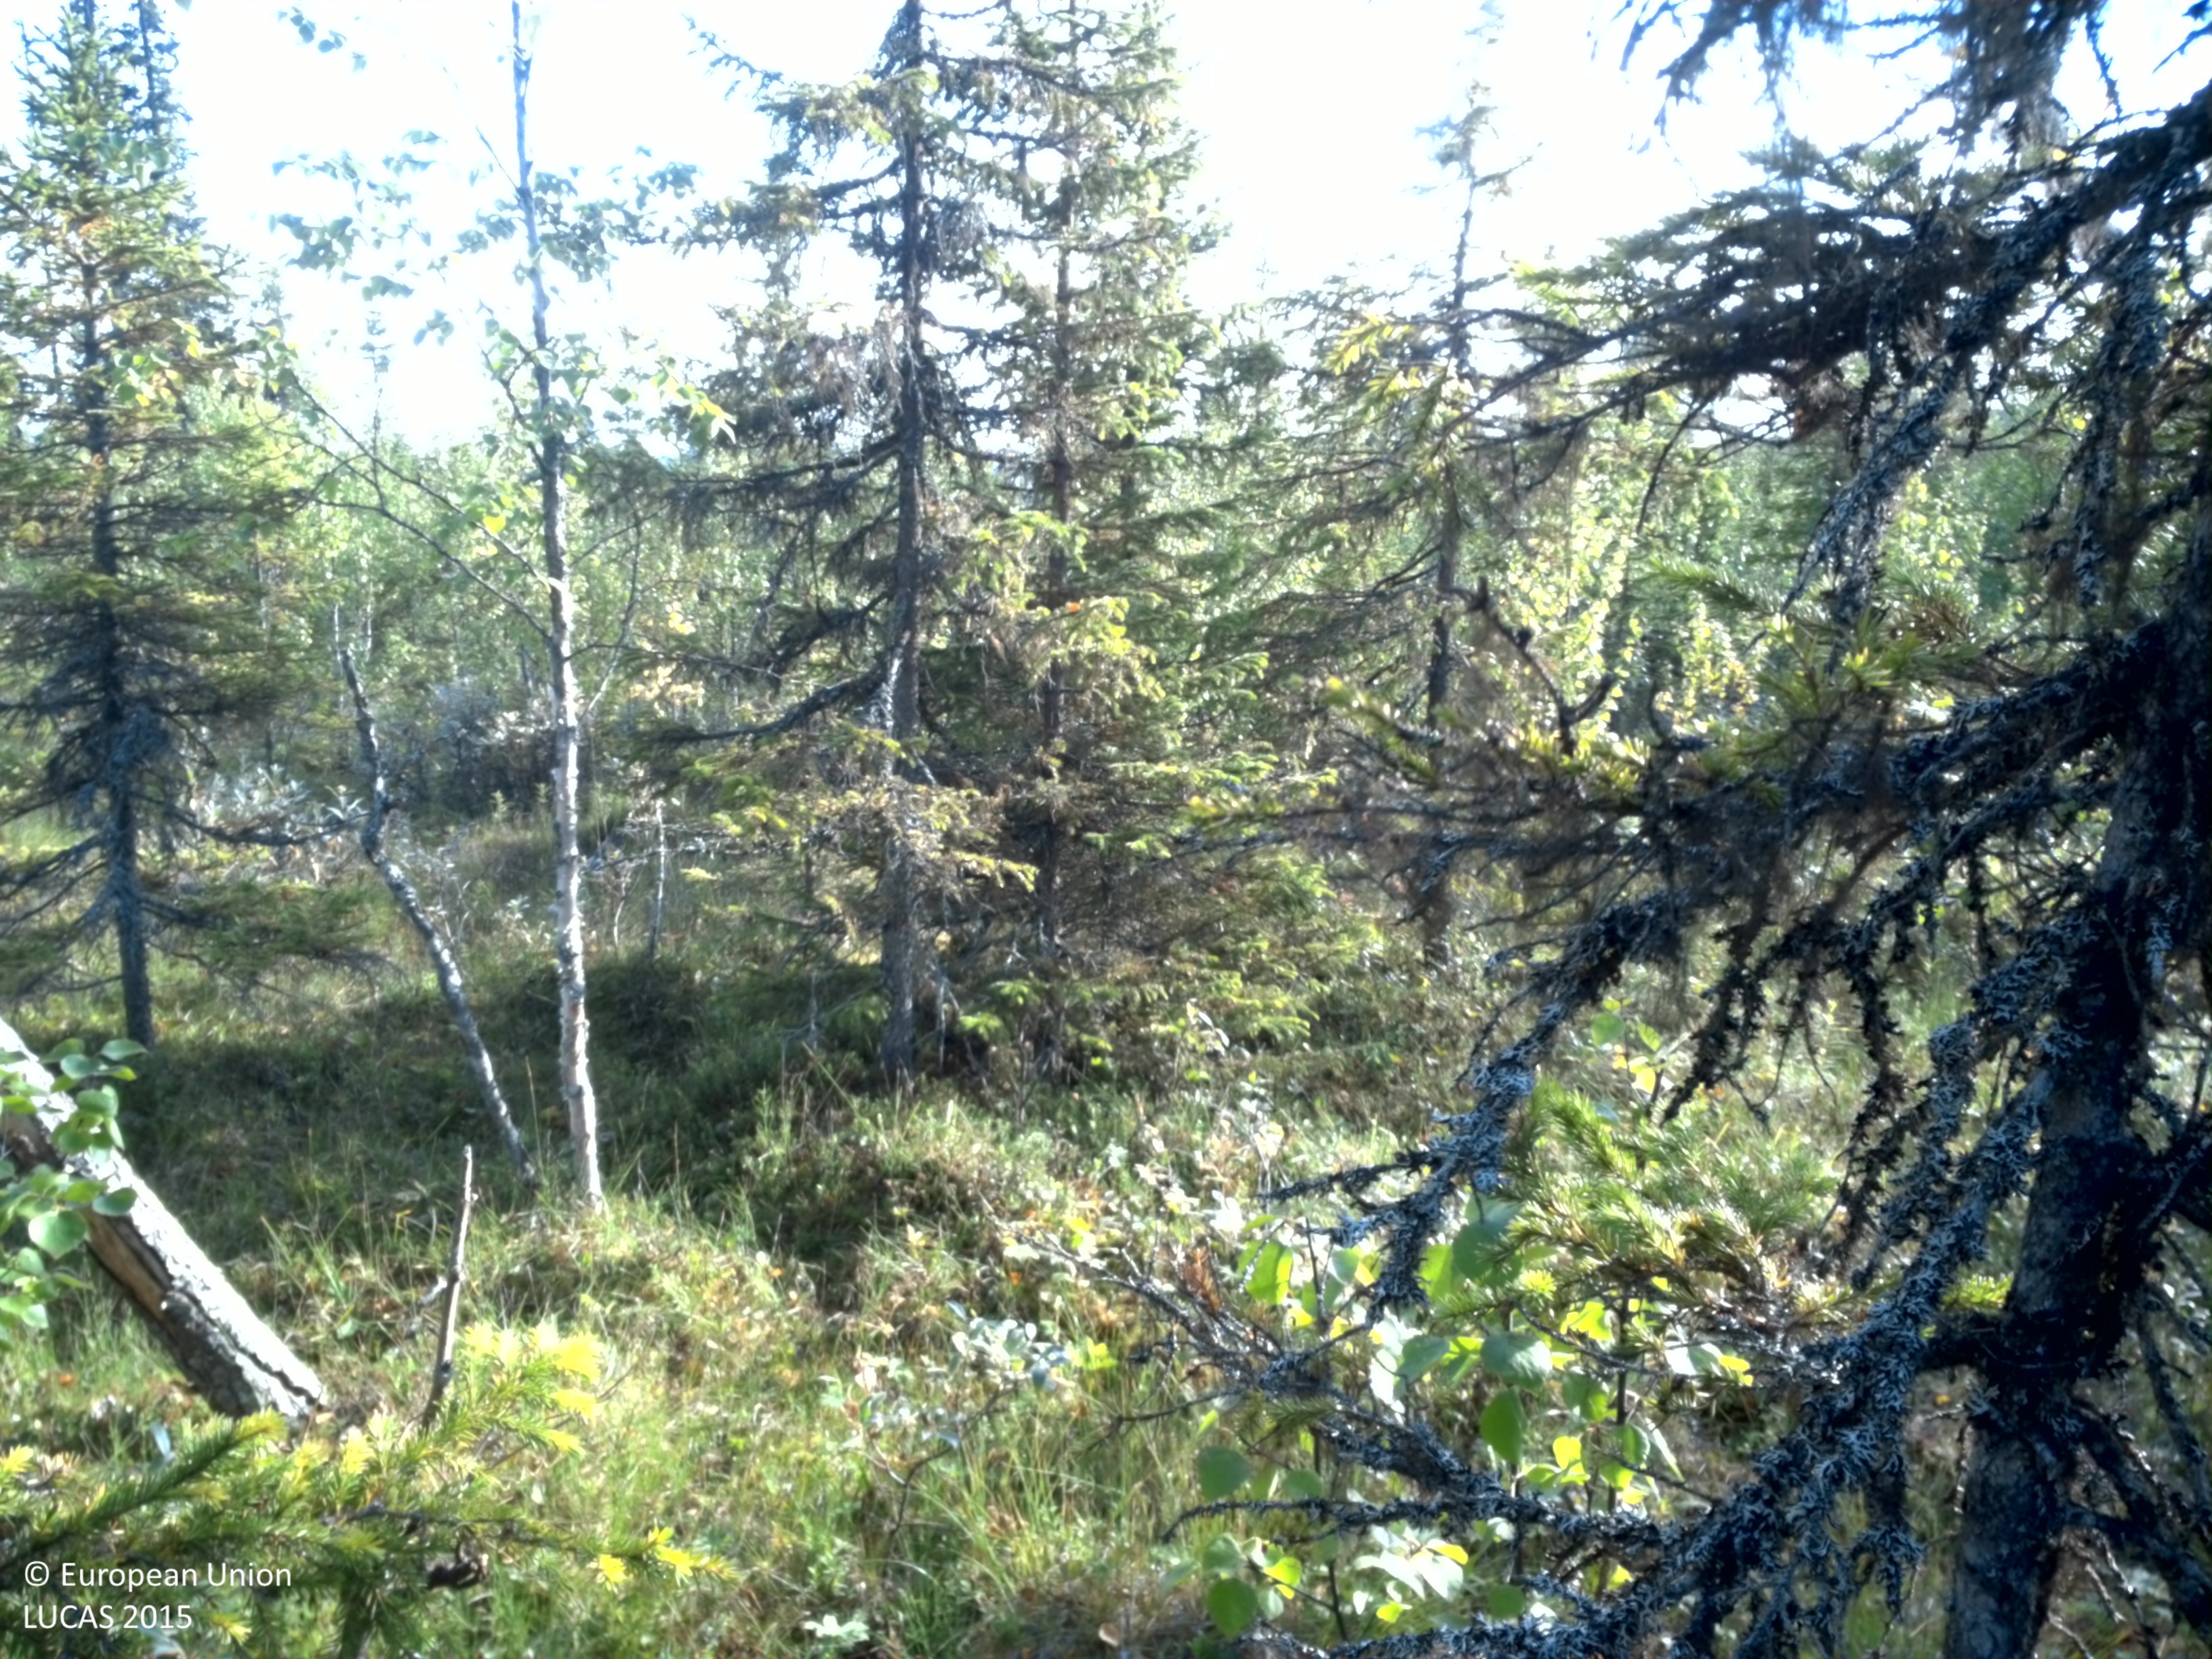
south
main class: Woodland
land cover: Spruce dominated mixed woodland
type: boreal forest
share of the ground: 25 - 50 %
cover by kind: shrubs 30 %, coniferous forest trees 25 %, herbaceous plants 20 %, lichens and mosses 15 %, broadleaved forest trees 10 %
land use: Forestry
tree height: > 5 m
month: September
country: SE
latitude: 65.1613
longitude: 16.3007
